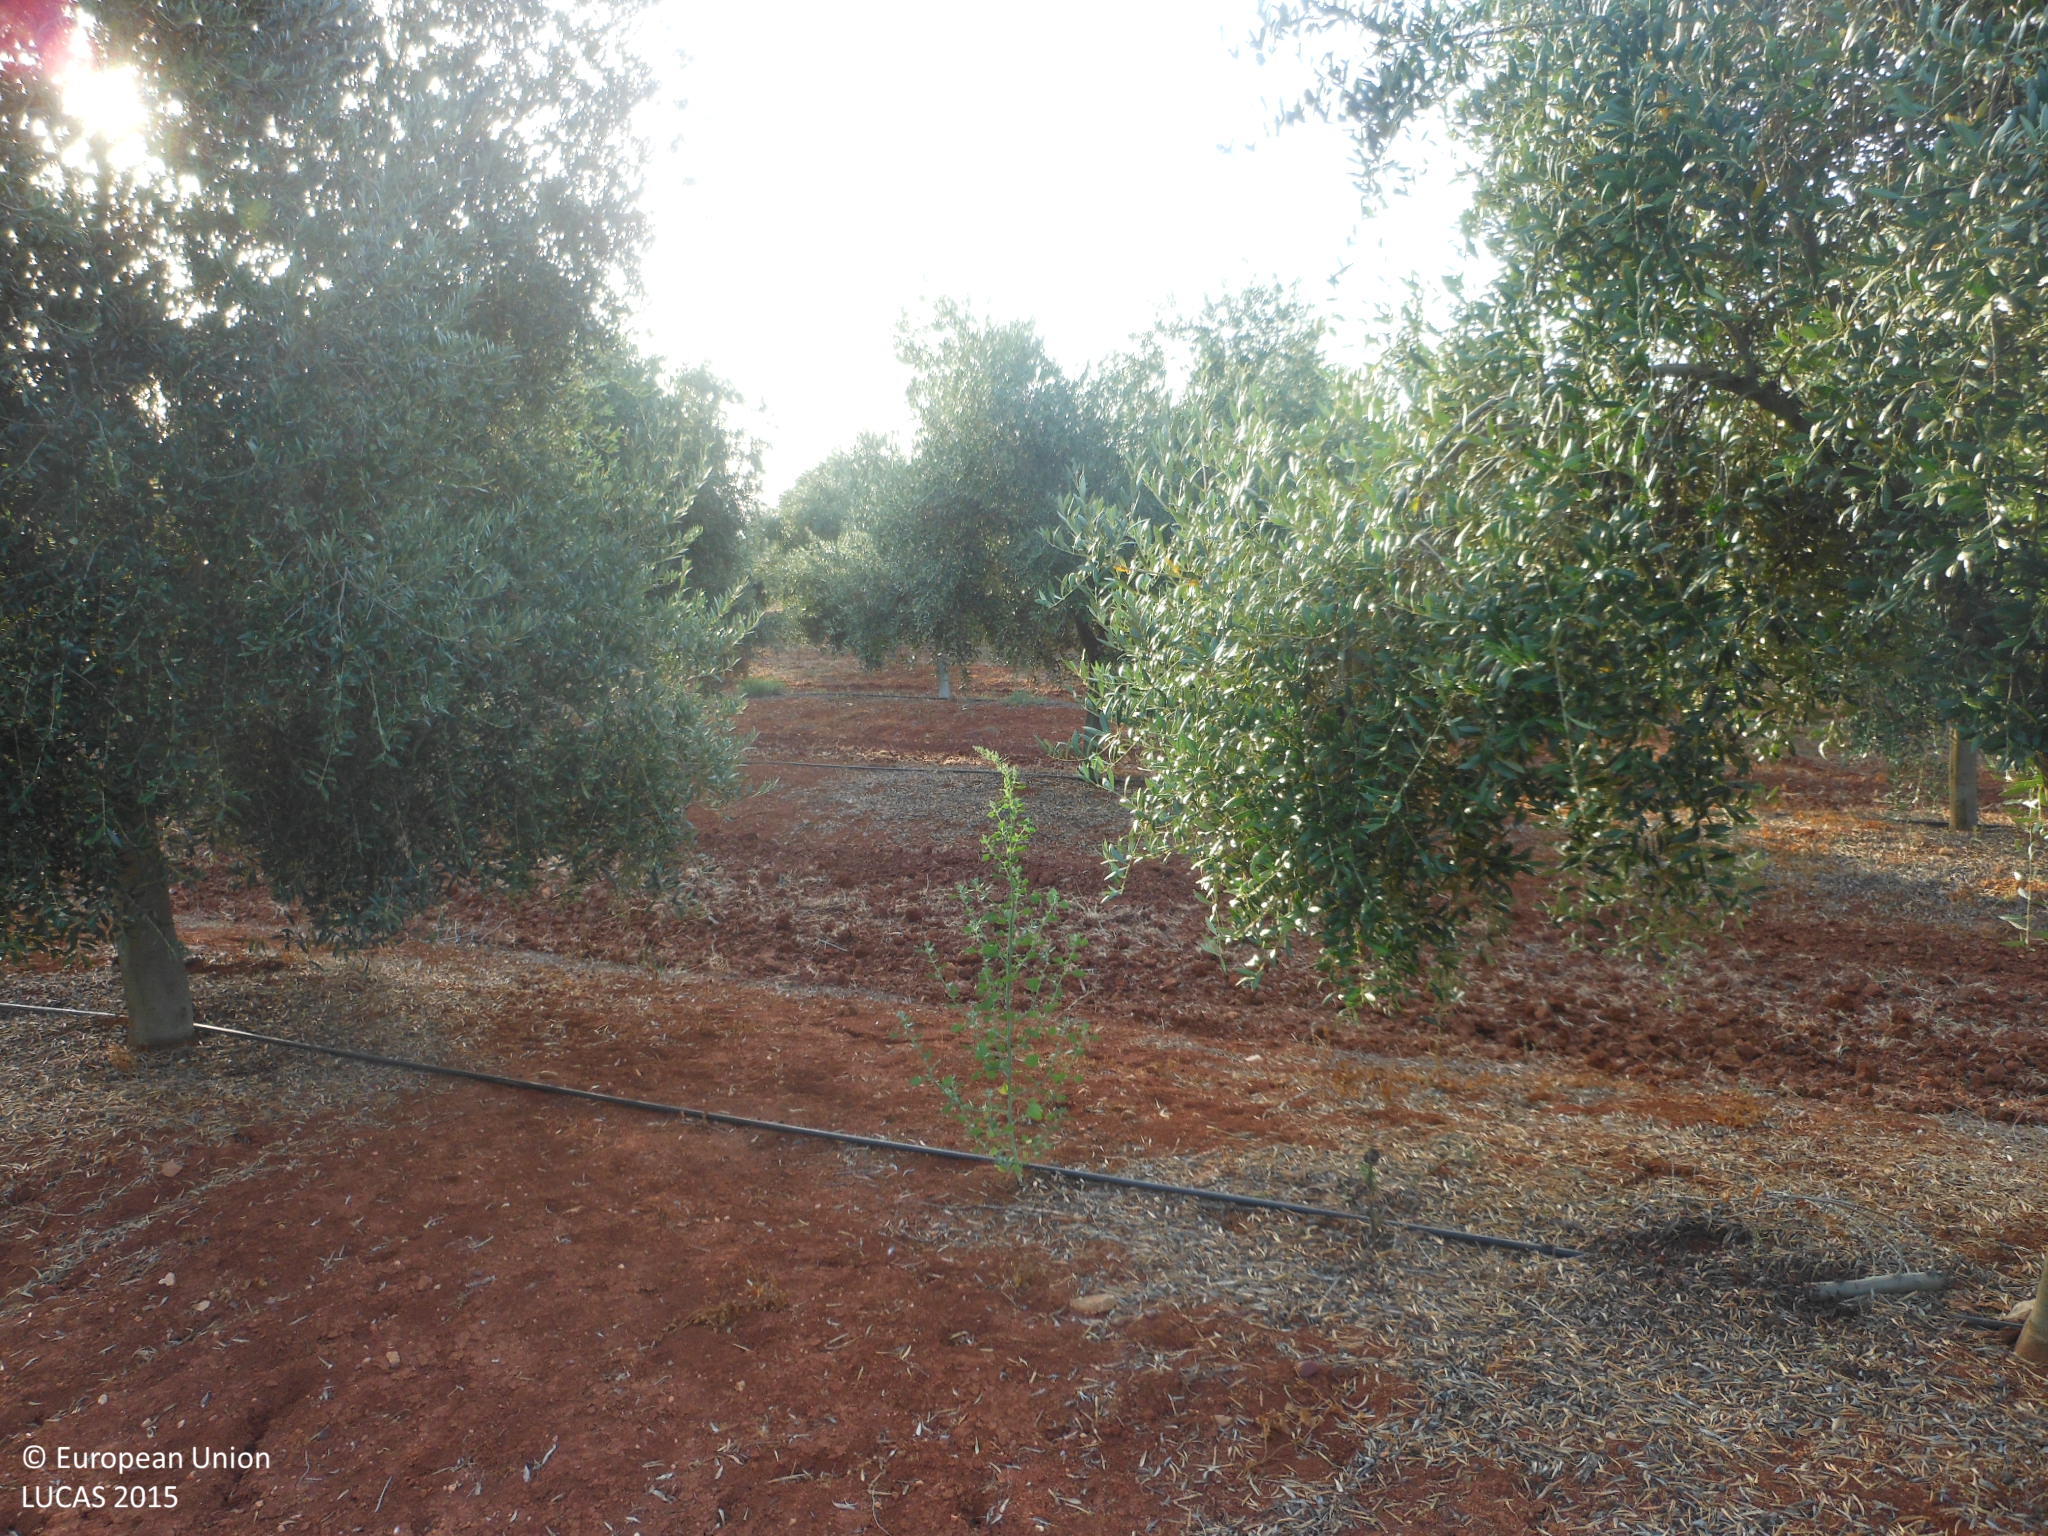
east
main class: Cropland
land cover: Olive groves
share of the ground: 25 - 50 %
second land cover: Other bare soil
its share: > 75 %
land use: Agriculture (excluding fallow land and kitchen gardens)
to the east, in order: Olive groves; Other bare soil; Grass margins; Paved roads, cycling and walking lanes; Grass margins; Ditches and canals; Grass margins; Olive groves
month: July
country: ES
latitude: 37.4825
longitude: -5.1552
